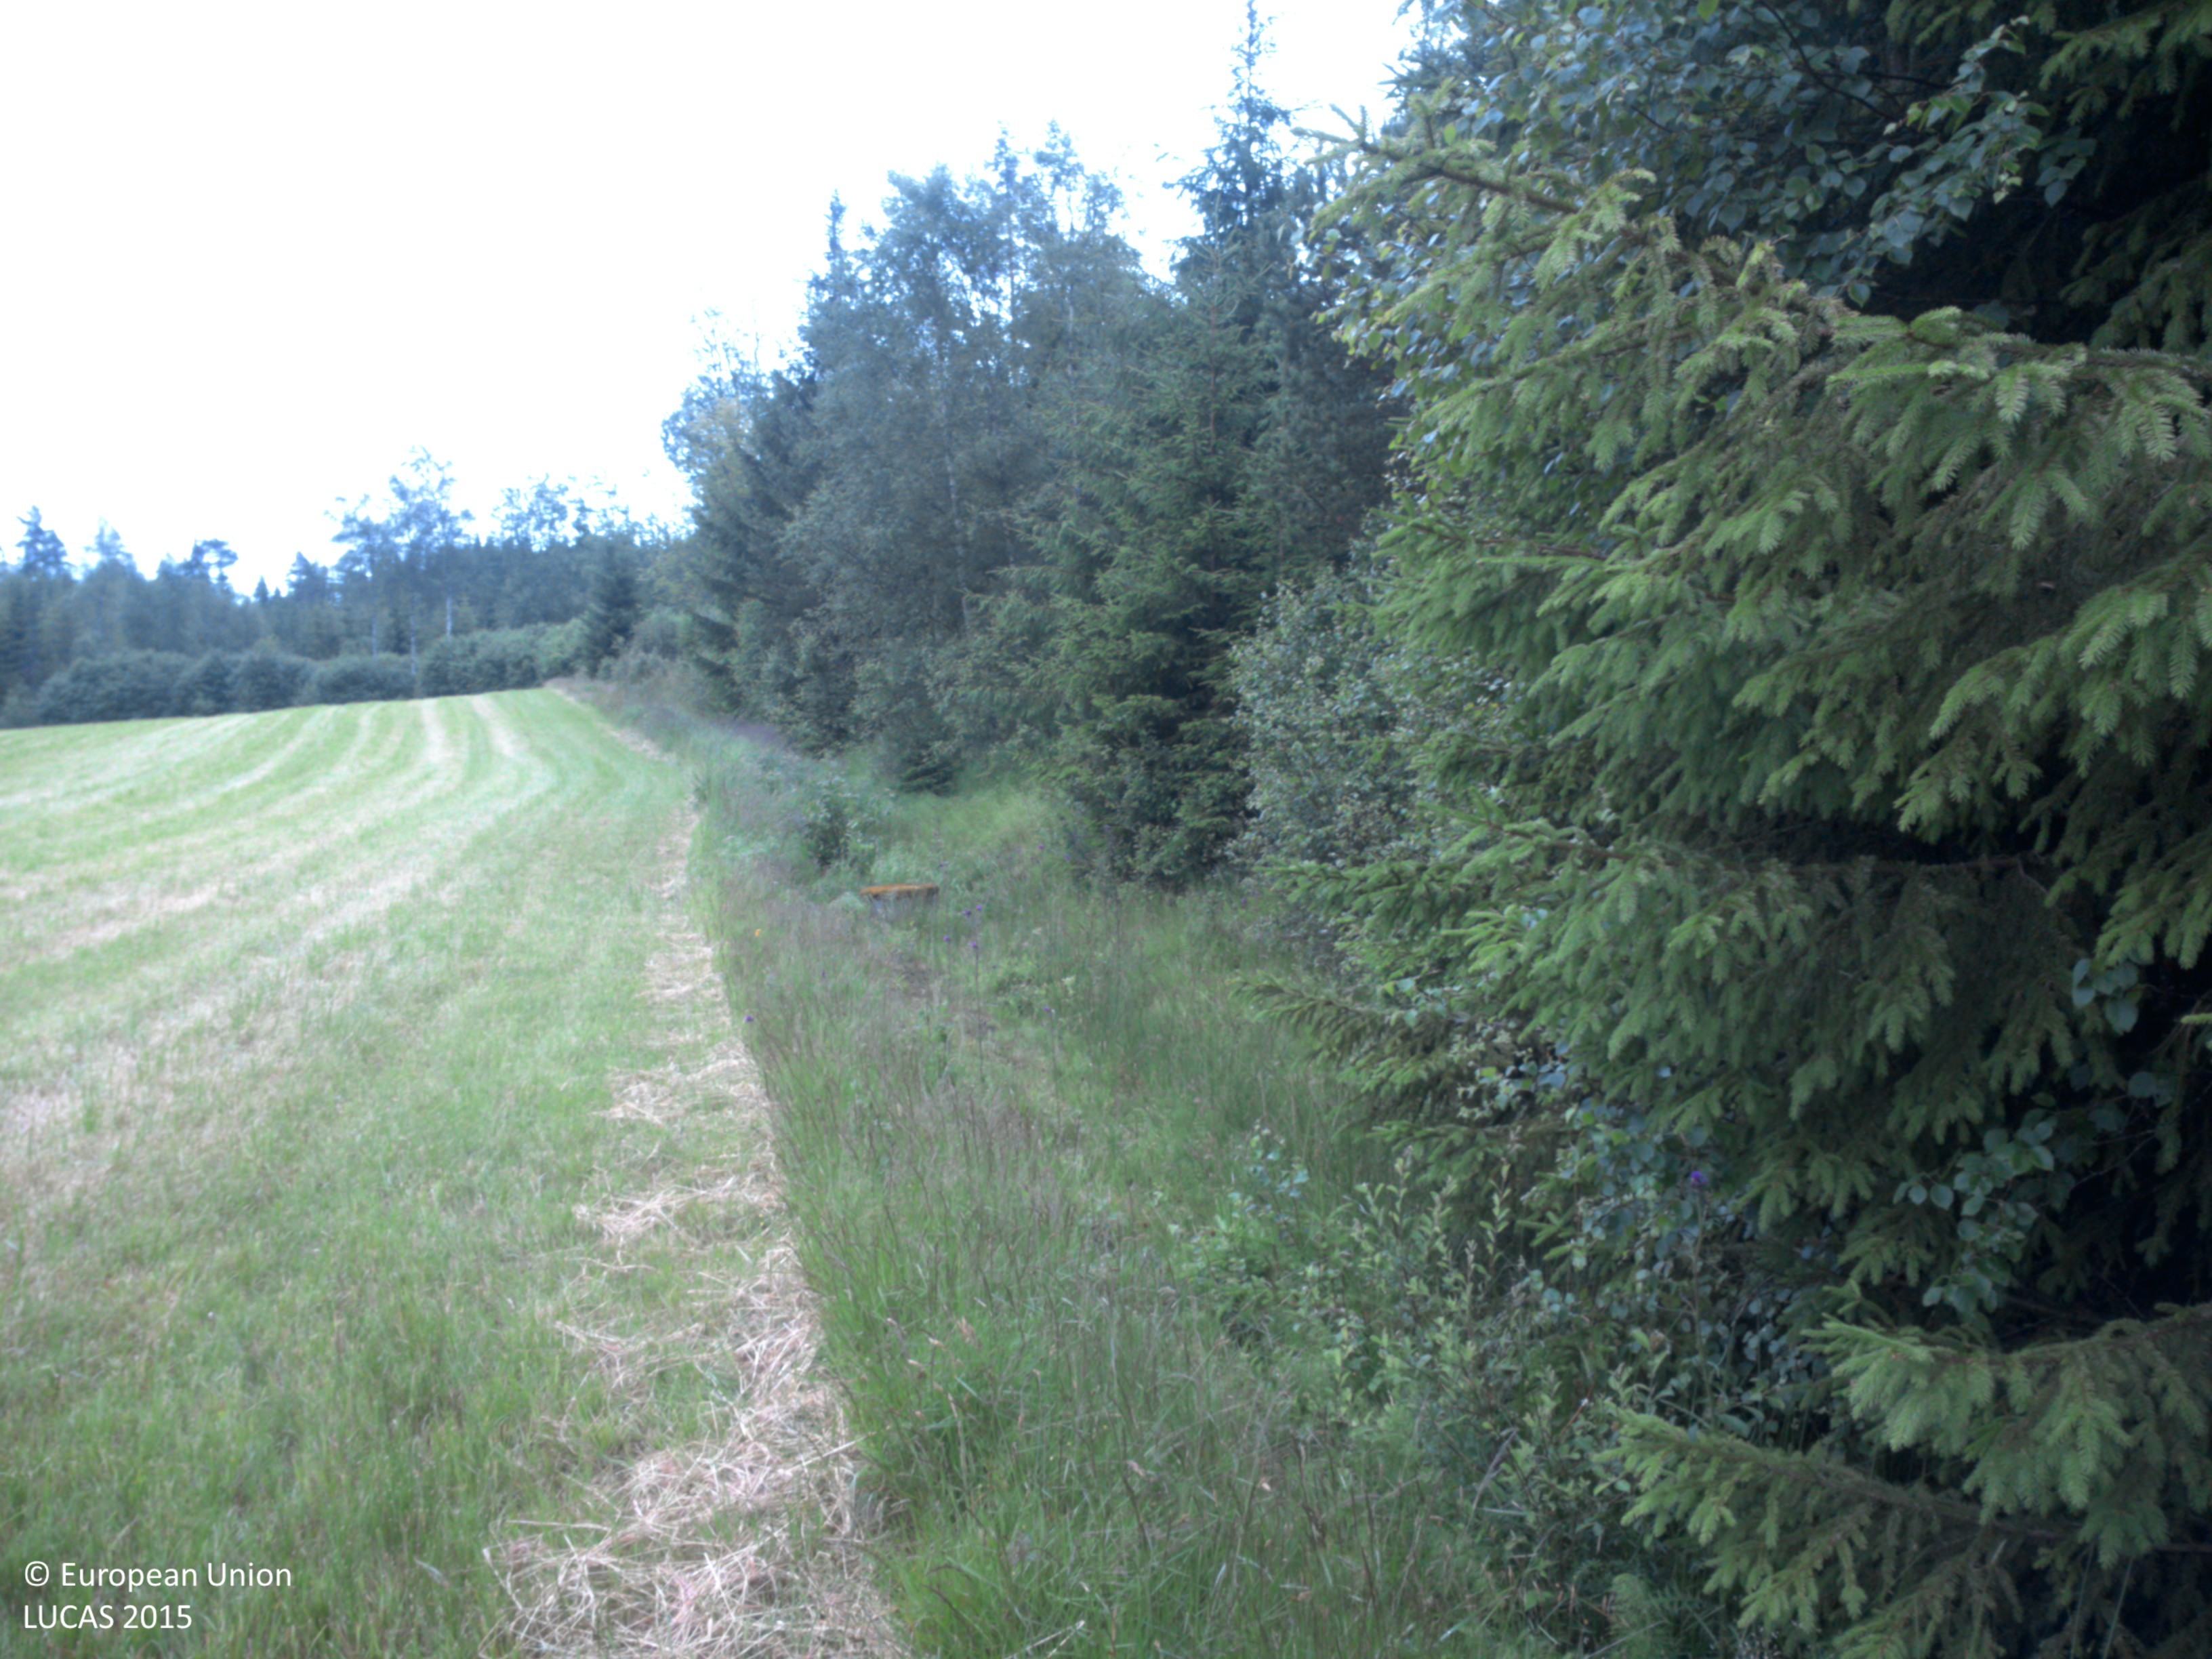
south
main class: Cropland
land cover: Mixed cereals for fodder
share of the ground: > 75 %
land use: Agriculture (excluding fallow land and kitchen gardens)
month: July
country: SE
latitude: 58.6707
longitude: 12.1164
